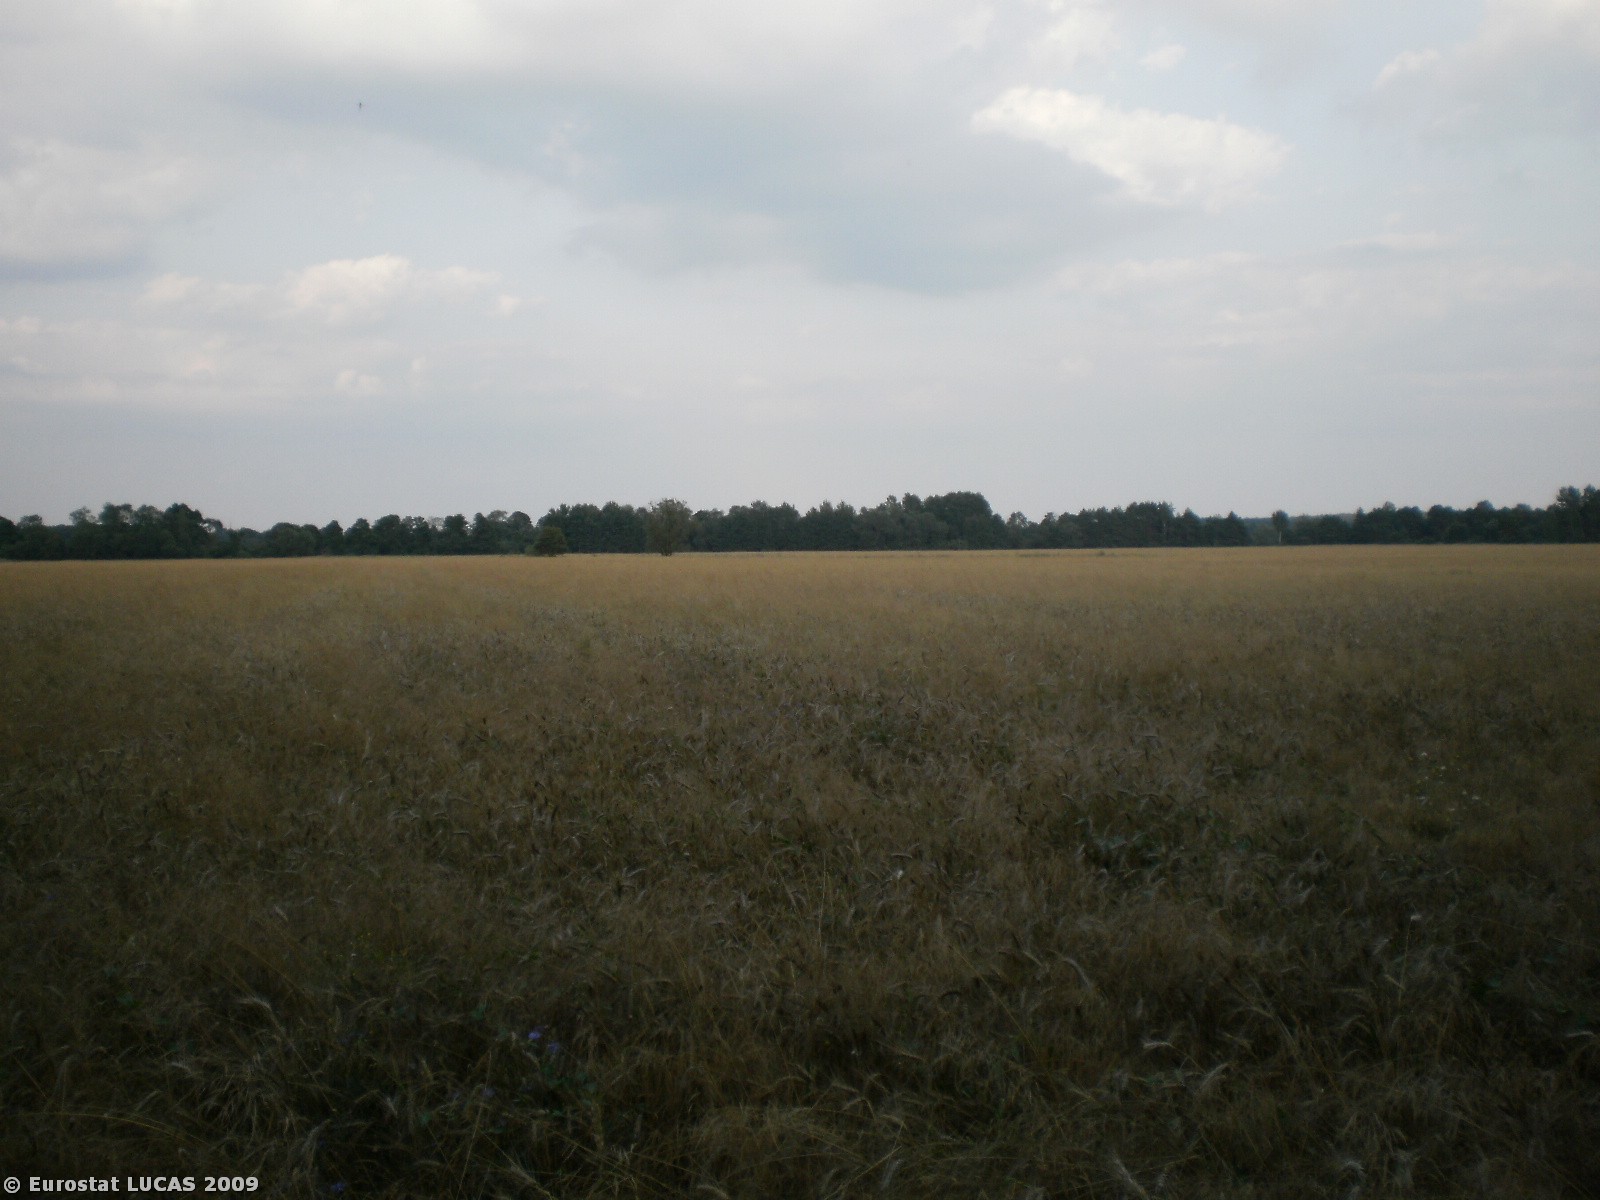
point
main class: Cropland
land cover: Triticale
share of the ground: > 75 %
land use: Agriculture (excluding fallow land and kitchen gardens)
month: July
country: PL
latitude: 53.4065
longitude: 21.0095
